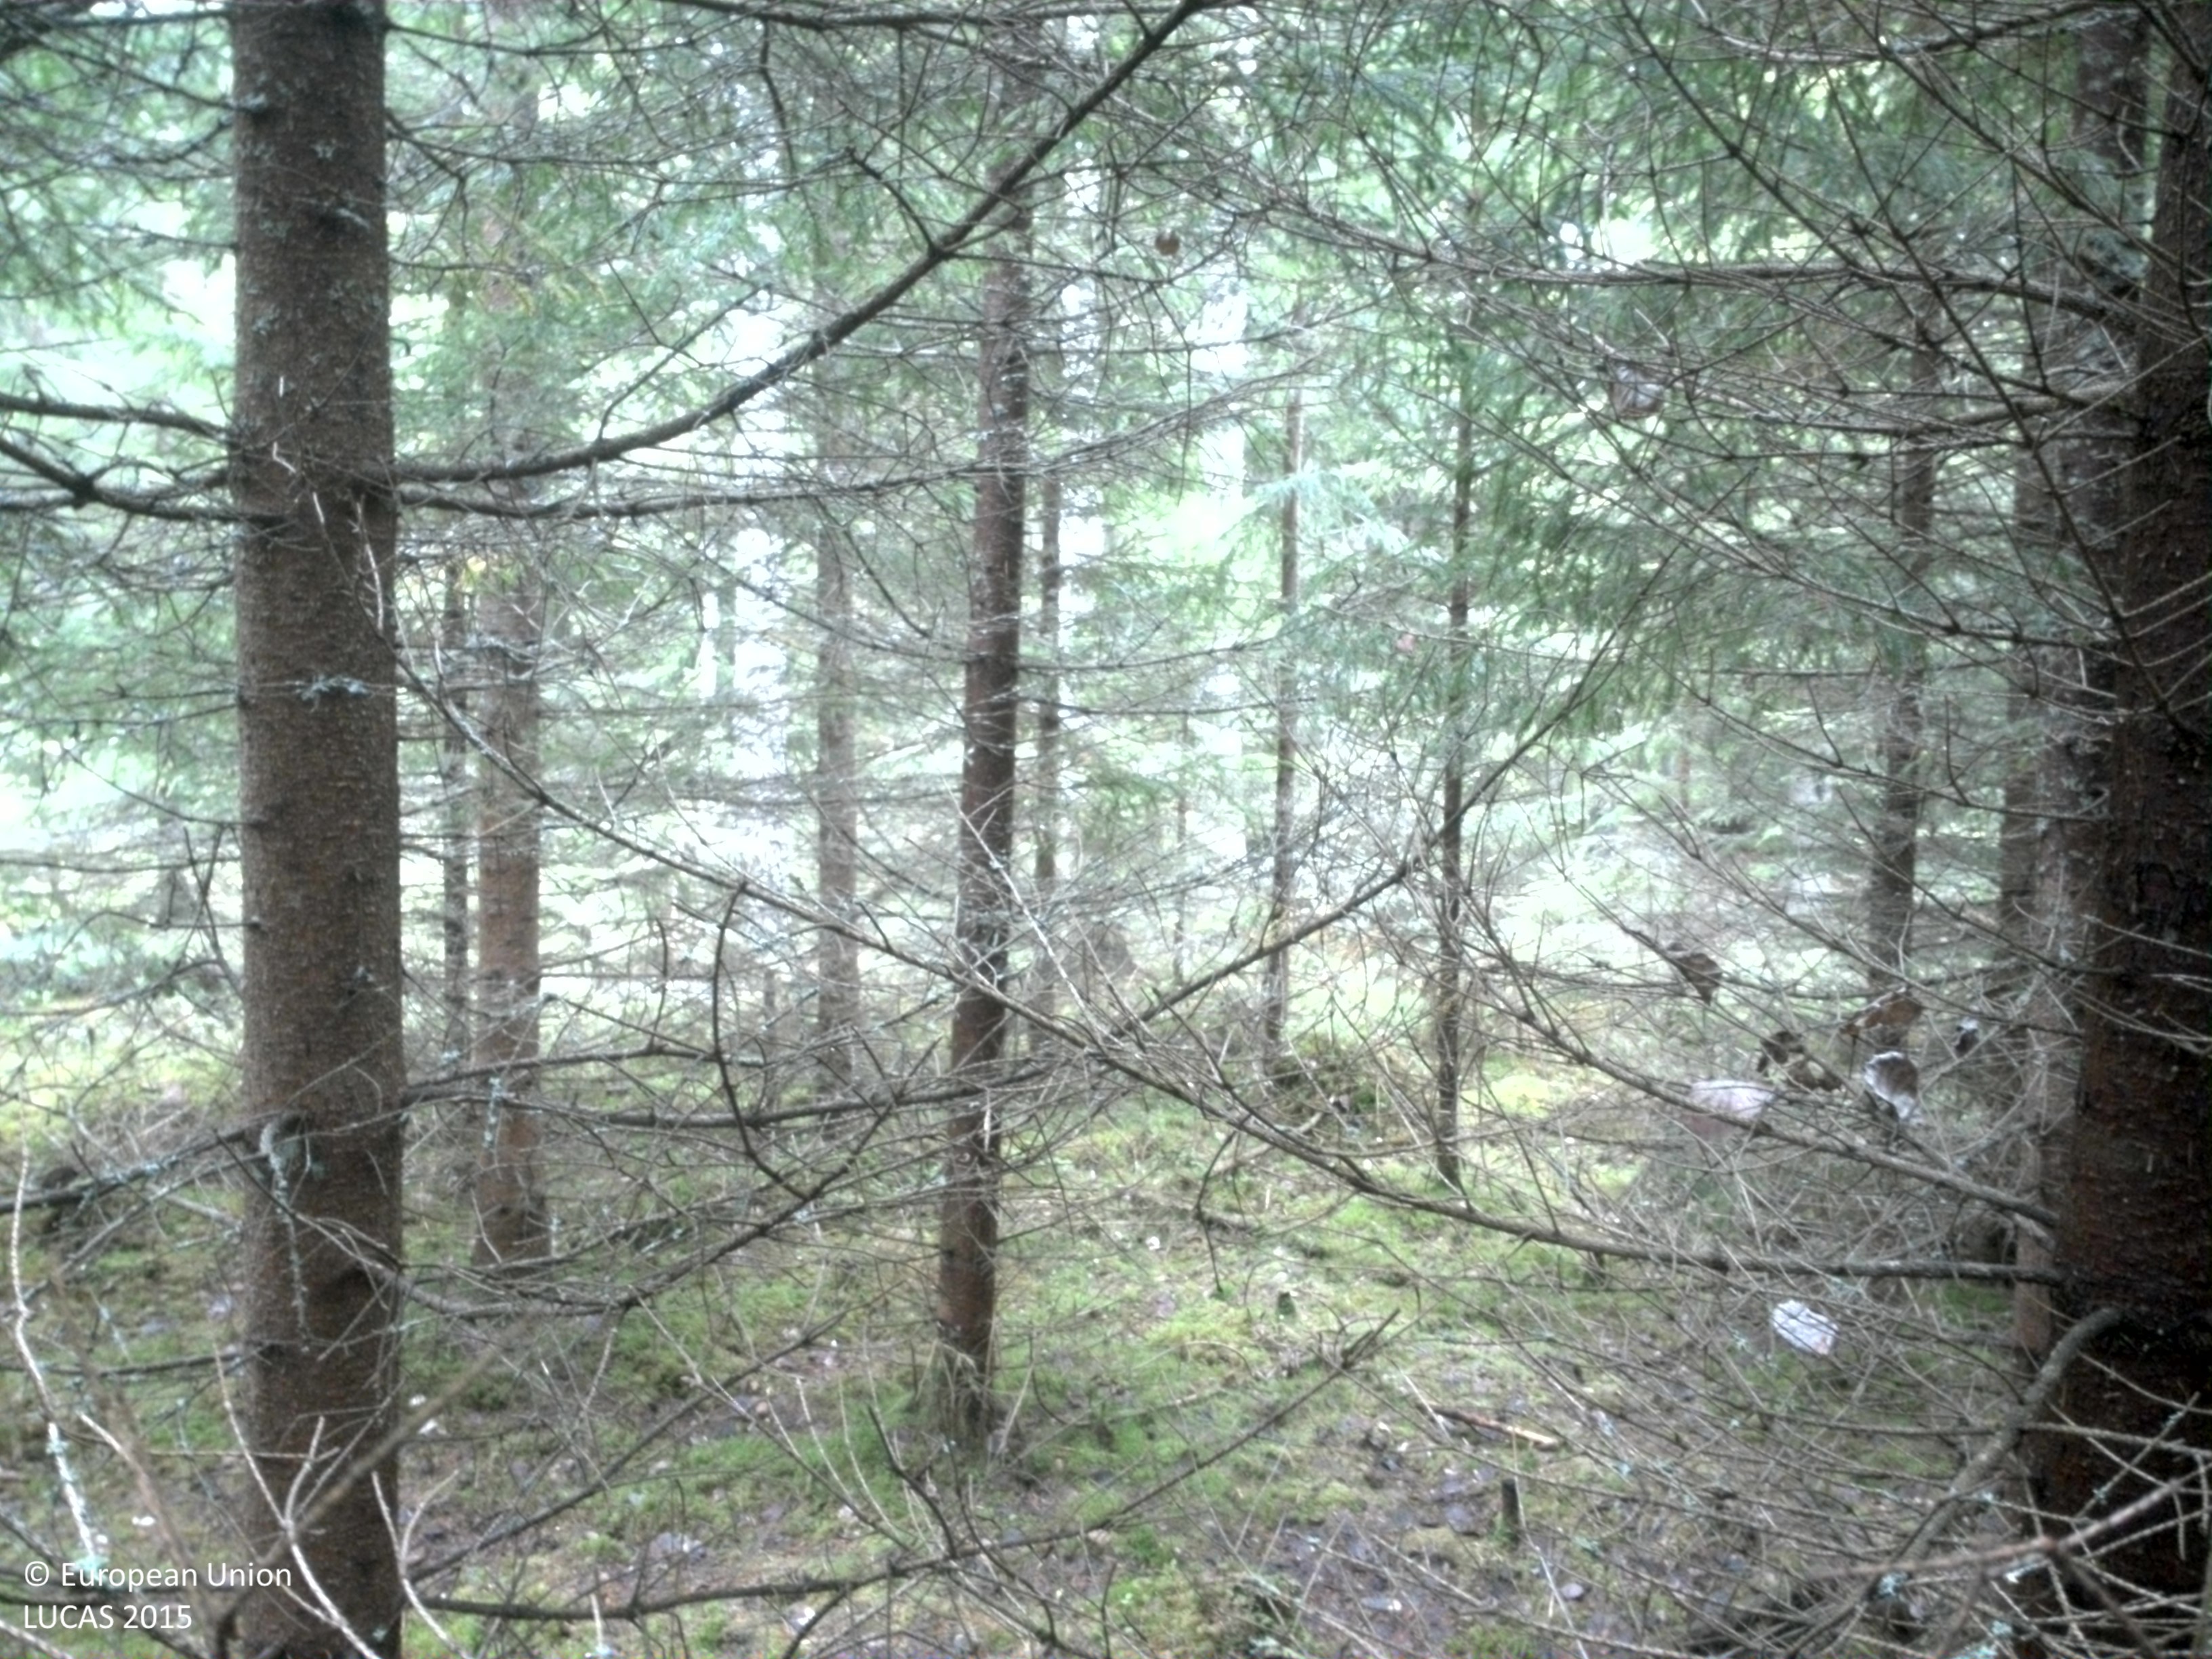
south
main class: Woodland
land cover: Spruce dominated coniferous woodland
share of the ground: > 75 %
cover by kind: coniferous forest trees 80 %, broadleaved forest trees 10 %, lichens and mosses 10 %
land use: Forestry
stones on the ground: < 10 %
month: August
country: SE
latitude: 57.8732
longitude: 13.9568
